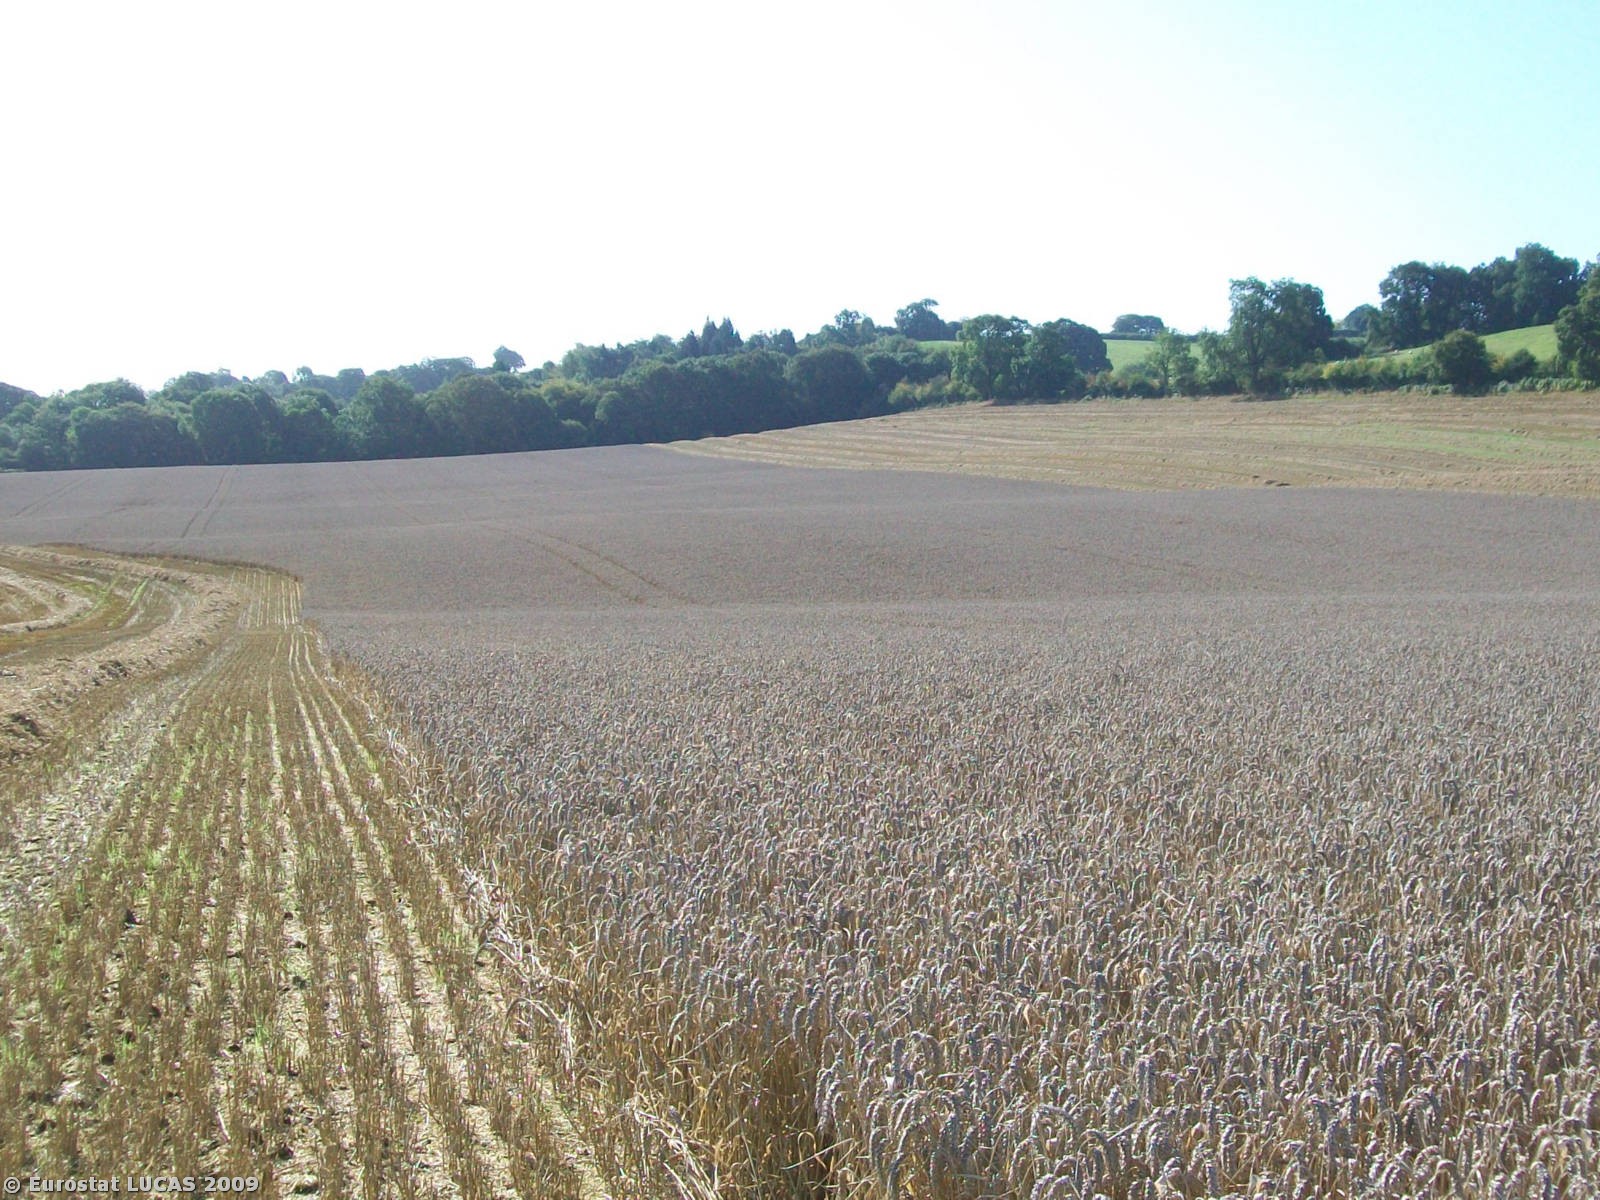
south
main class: Cropland
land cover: Common wheat
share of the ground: > 75 %
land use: Agriculture (excluding fallow land and kitchen gardens)
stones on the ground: < 10 %
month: September
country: GB
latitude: 52.2383
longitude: -2.5288
